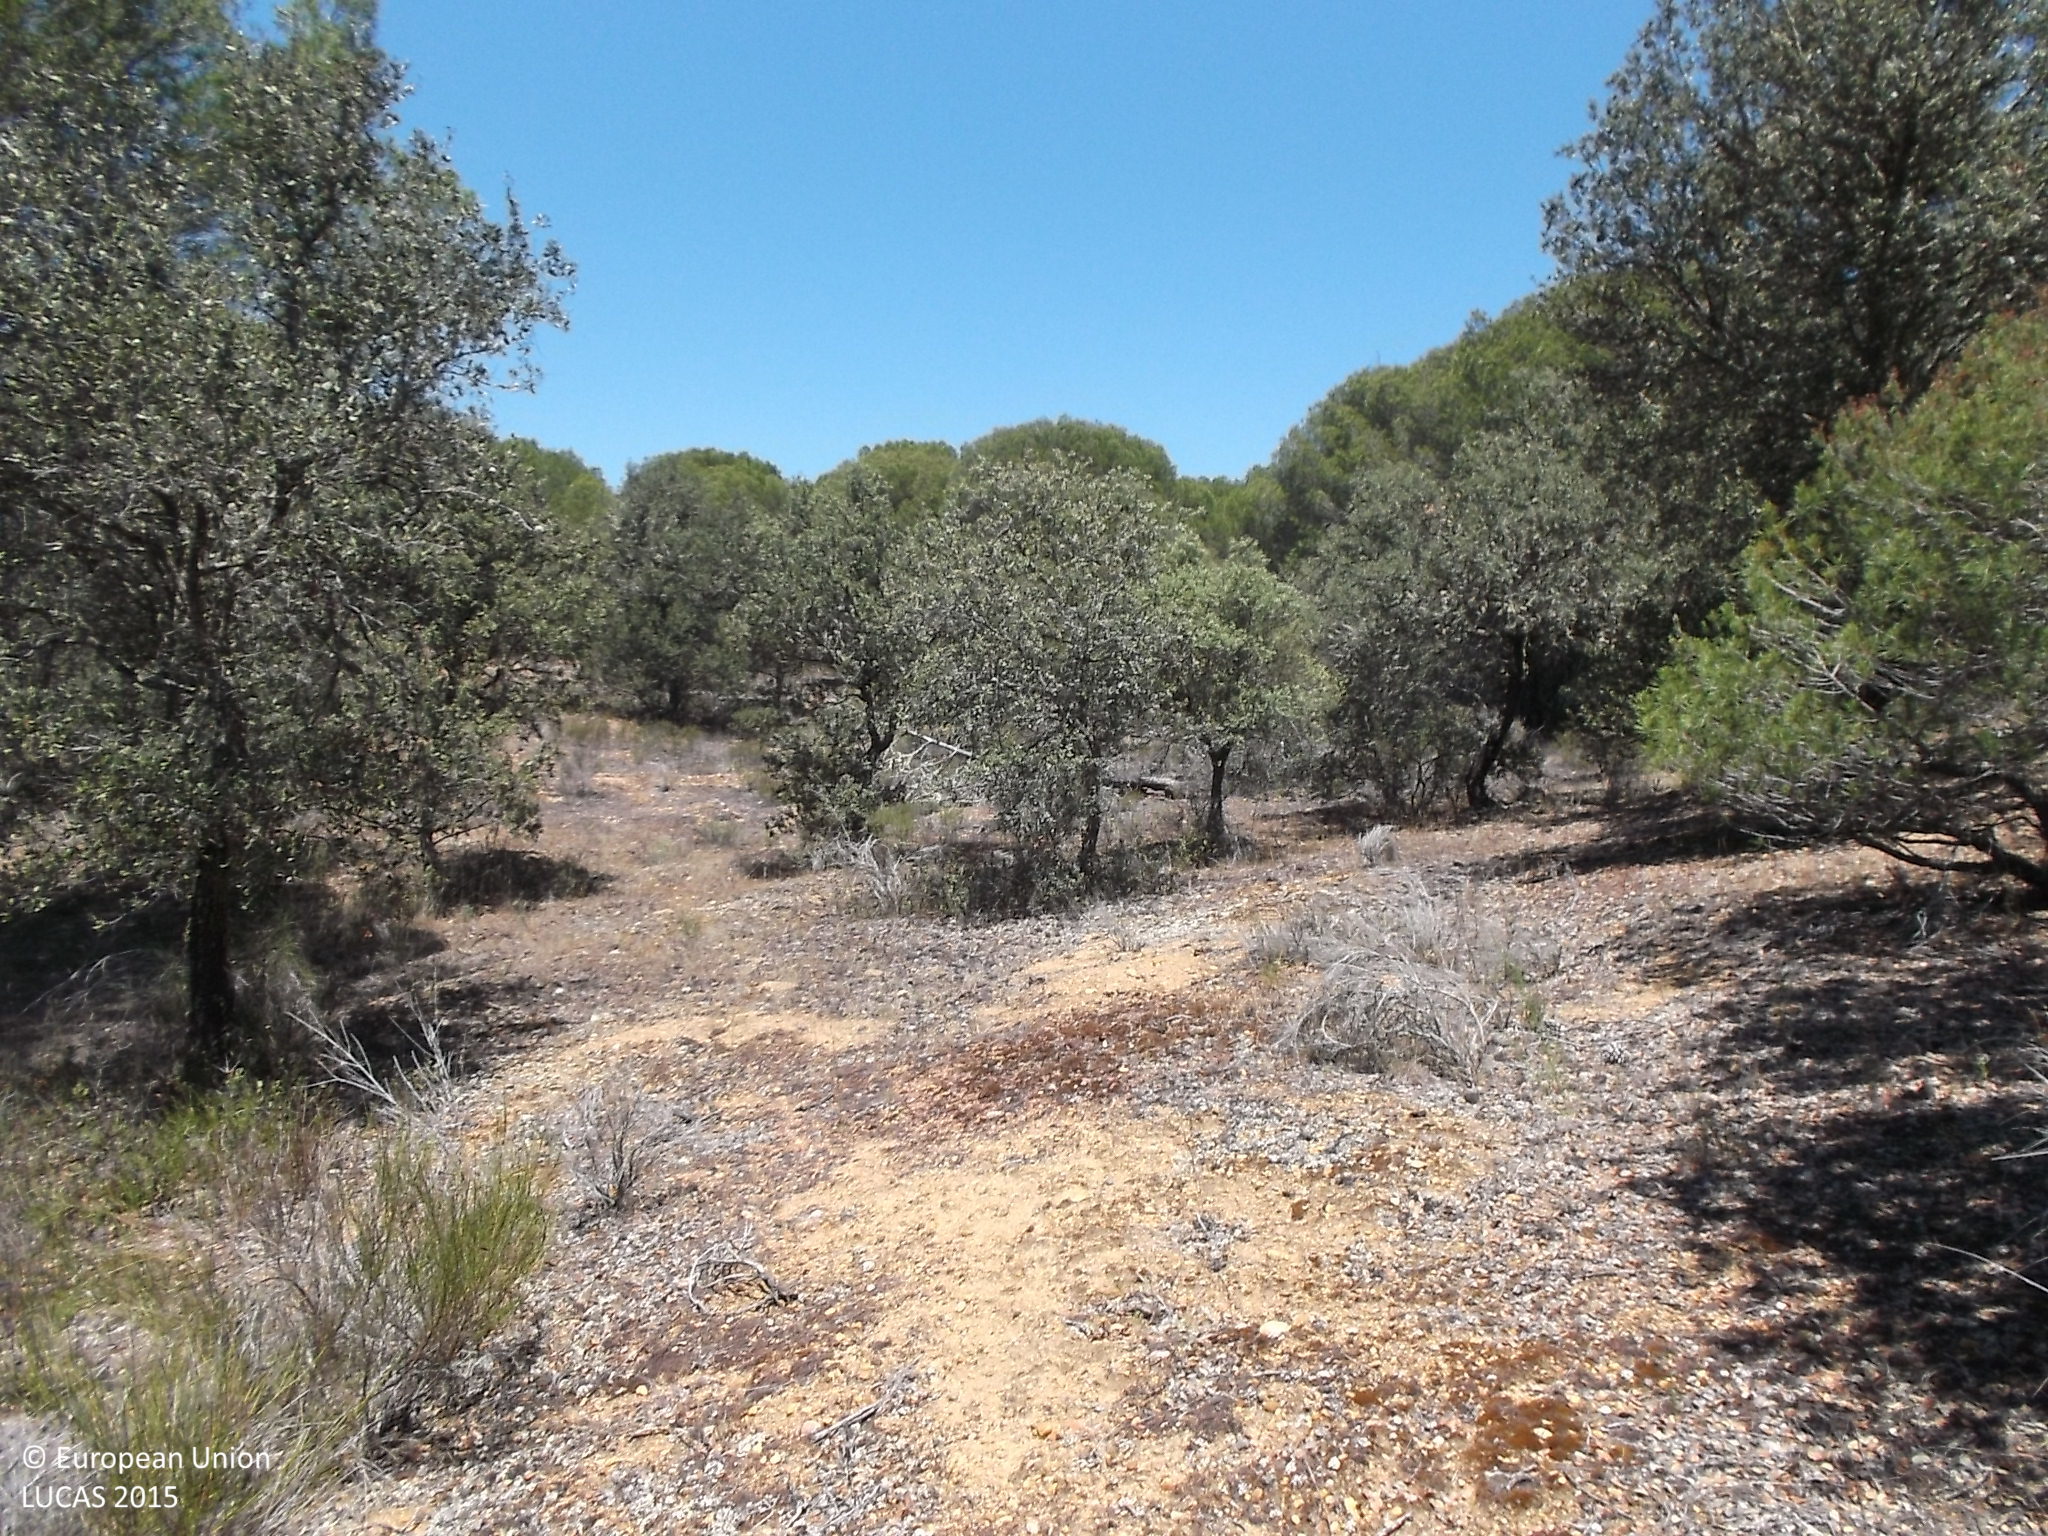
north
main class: Woodland
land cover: Other mixed woodland
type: coniferous forest of the mediterranean region
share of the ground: 50 - 75 %
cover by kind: coniferous forest trees 50 %, broadleaved forest trees 20 %, shrubs 20 %, herbaceous plants 10 %
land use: Forestry
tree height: > 5 m
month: June
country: ES
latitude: 41.4154
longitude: -5.5019
